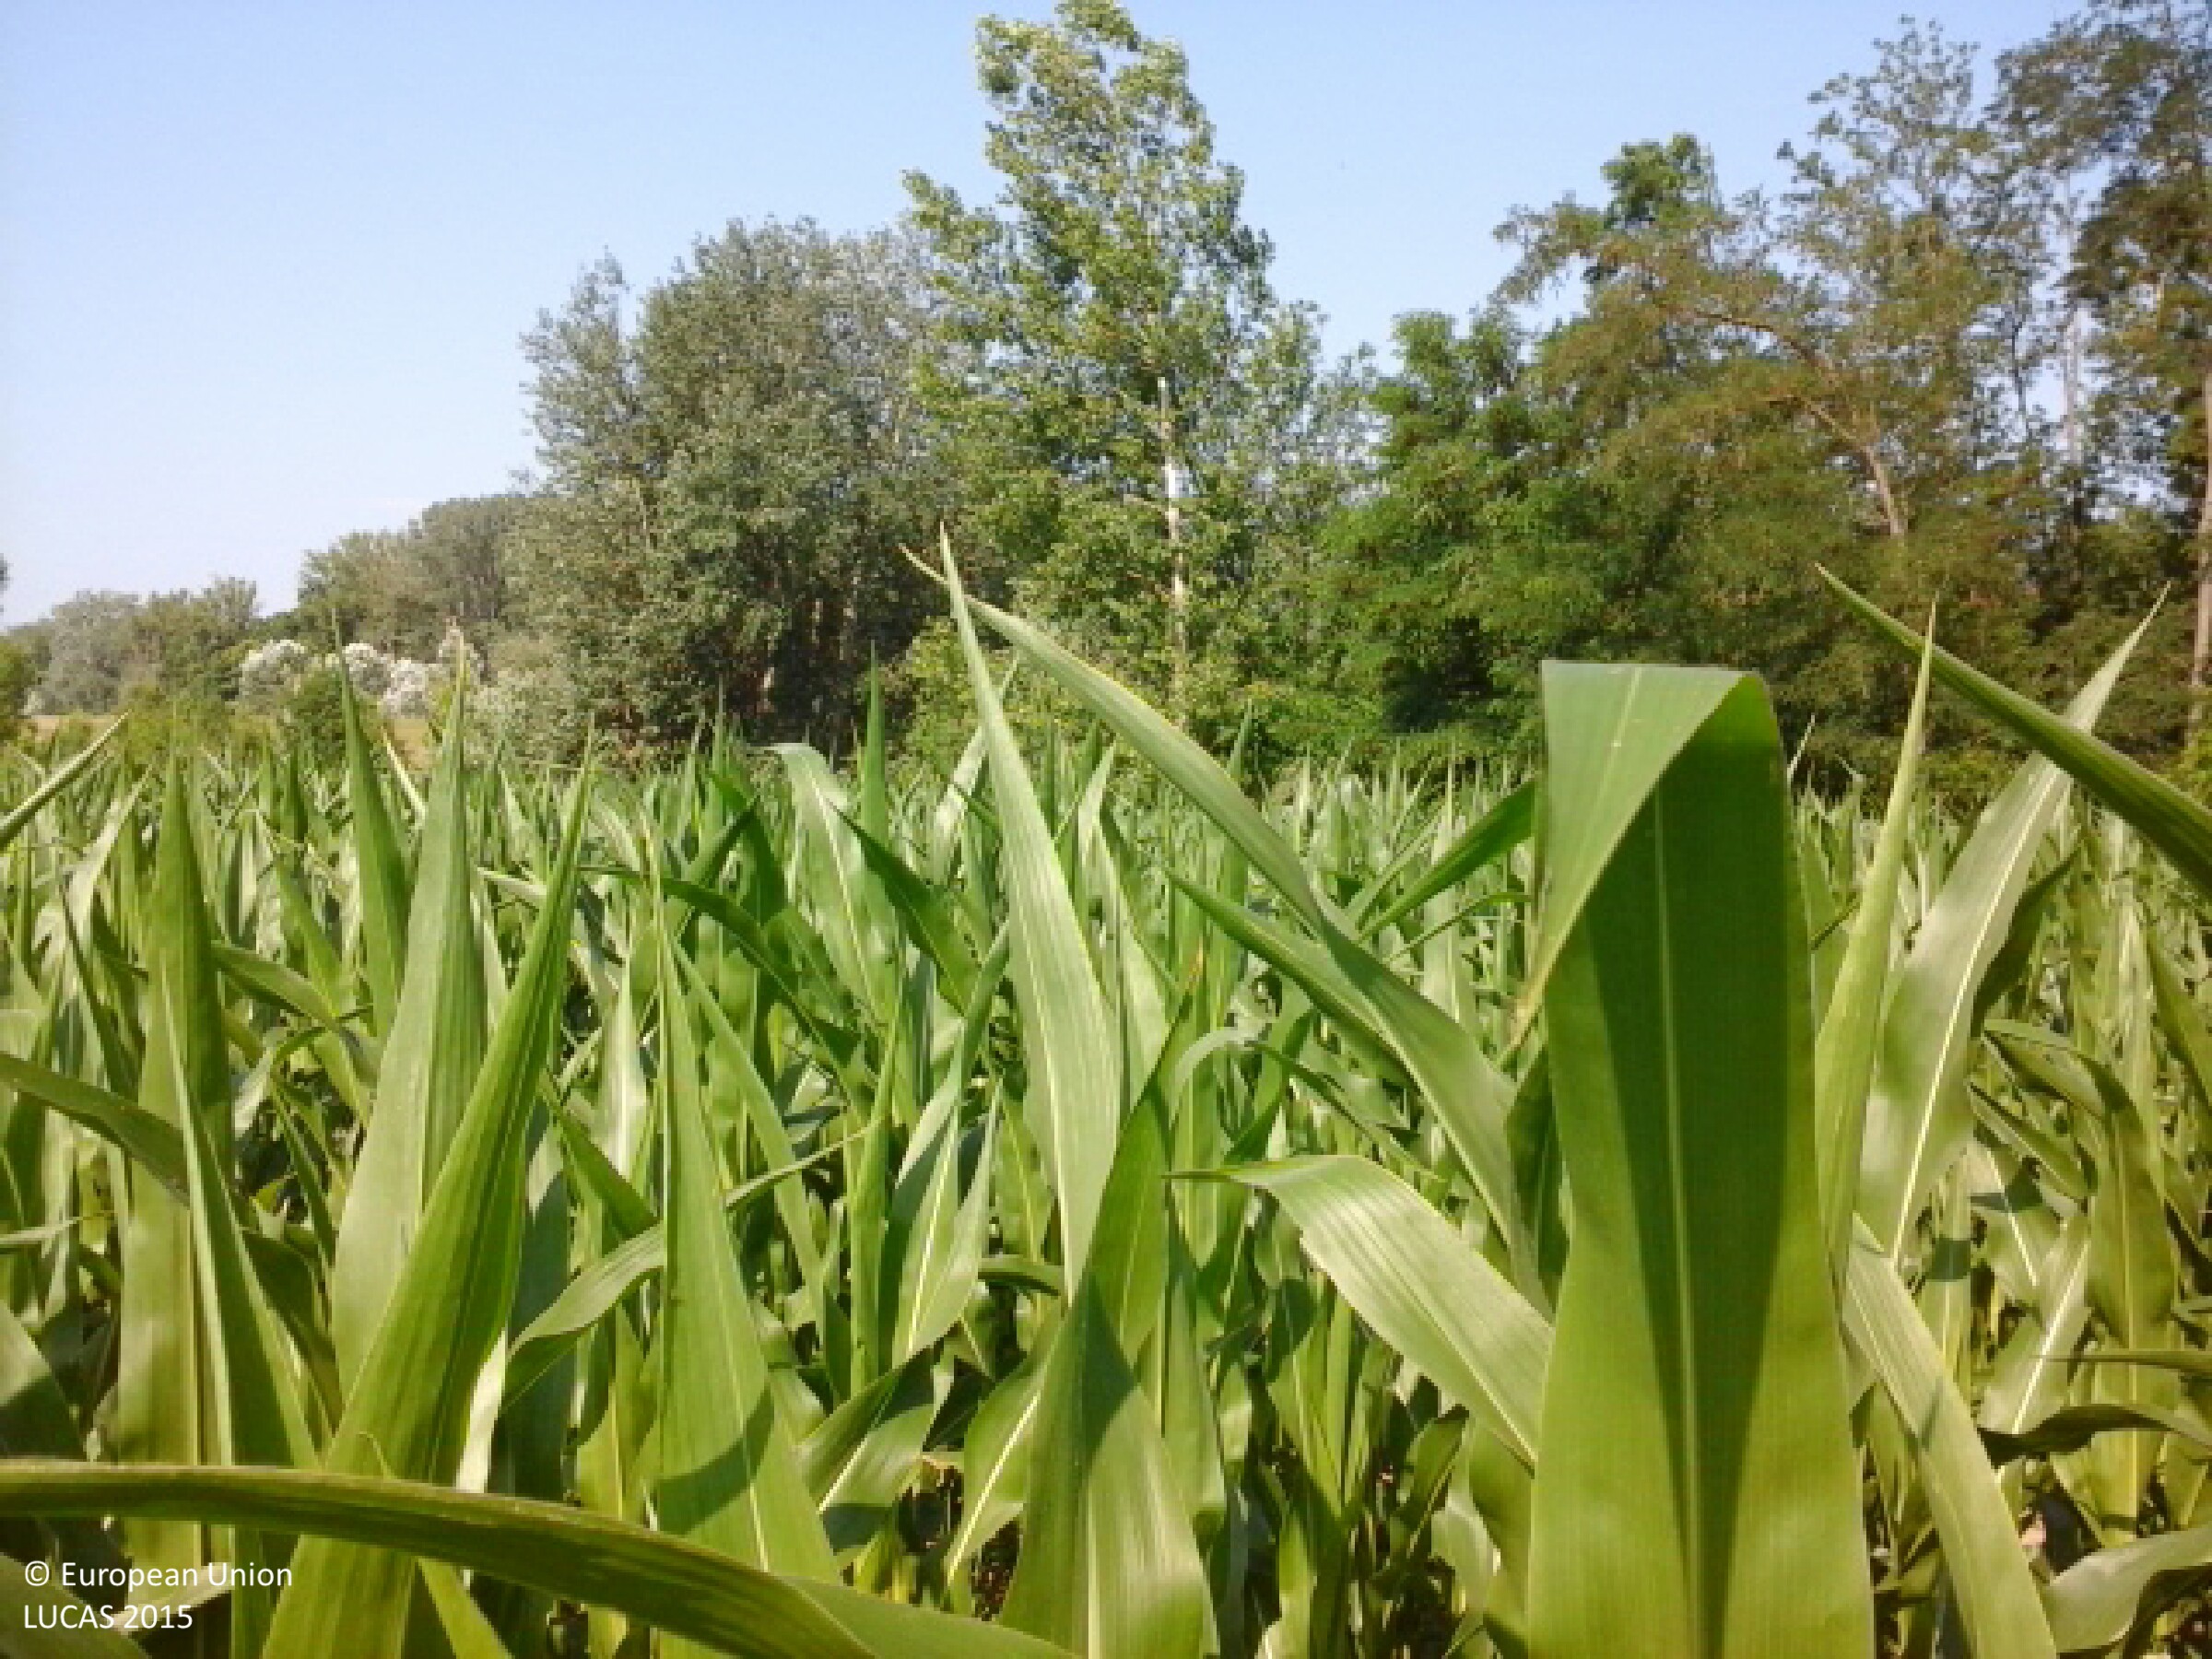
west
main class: Cropland
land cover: Maize
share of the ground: > 75 %
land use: Agriculture (excluding fallow land and kitchen gardens)
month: June
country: HU
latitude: 48.2058
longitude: 21.7972
